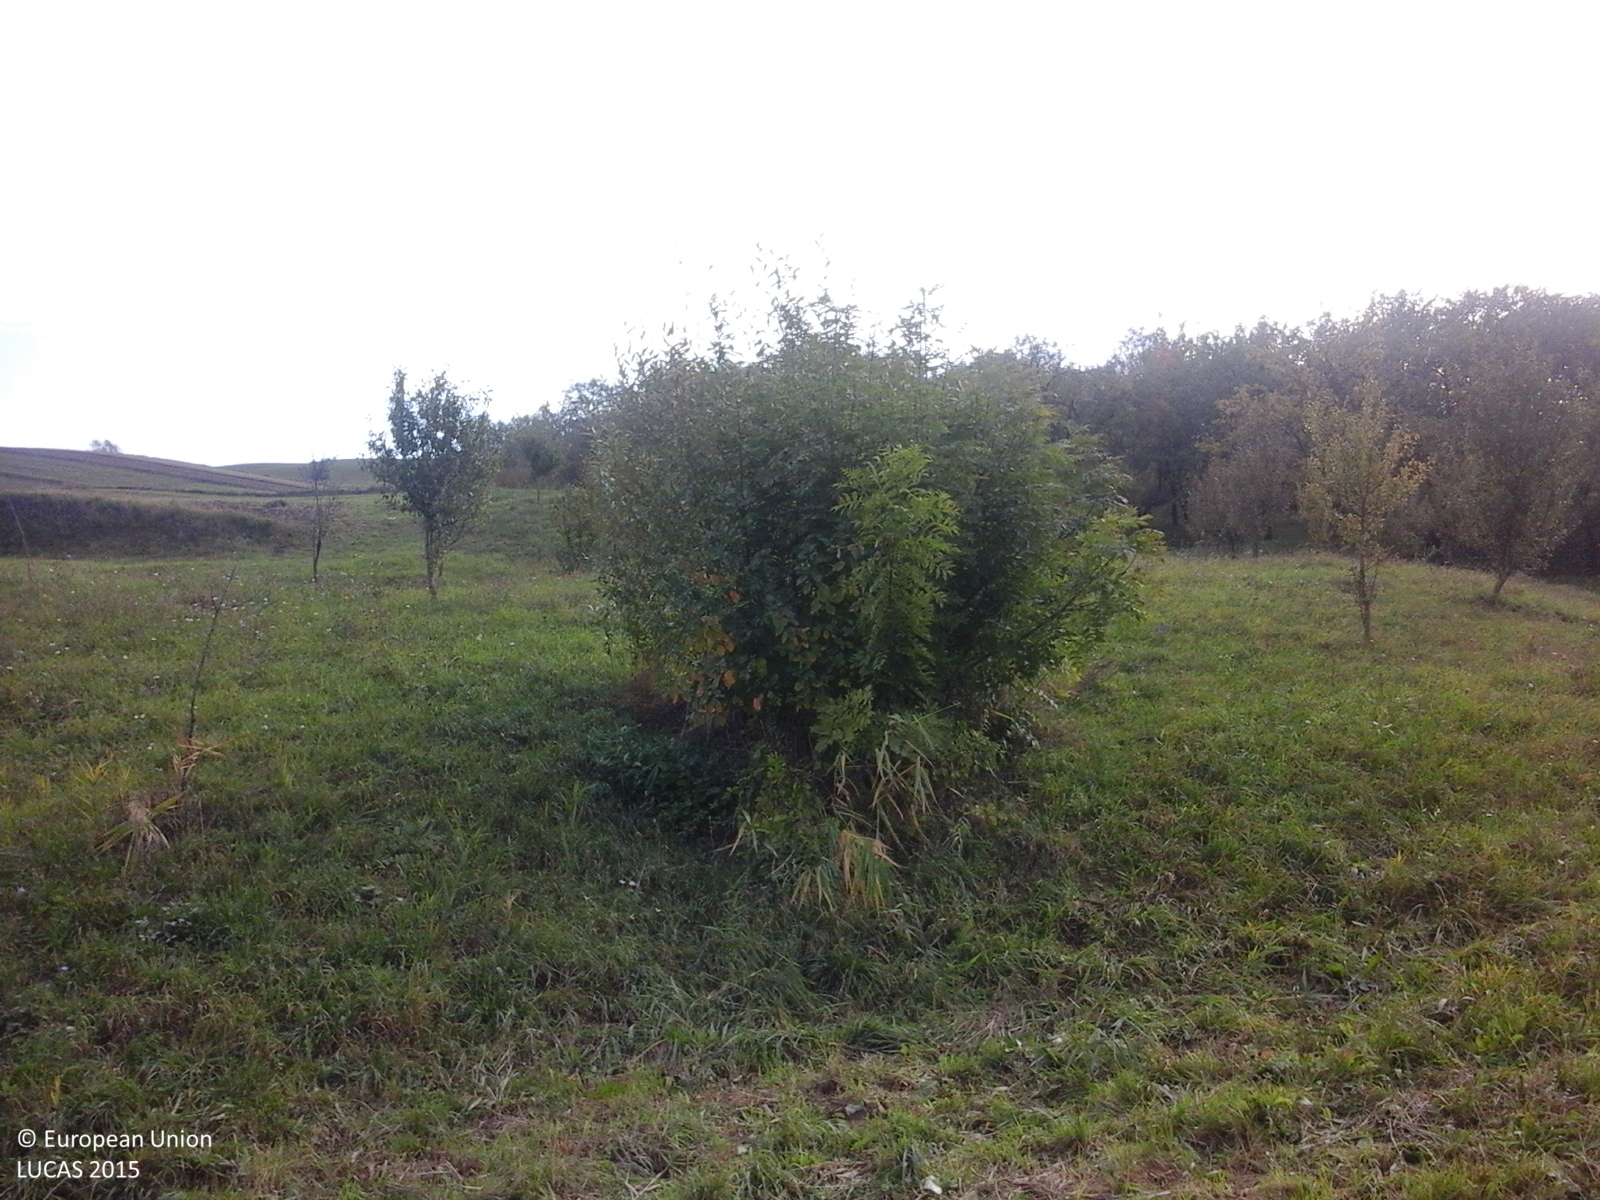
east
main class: Grassland
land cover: Grassland without tree/shrub cover
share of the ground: > 75 %
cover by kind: herbaceous plants 100 %
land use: Agriculture (excluding fallow land and kitchen gardens)
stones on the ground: < 10 %
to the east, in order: Grassland without tree/shrub cover; Other fruit trees and berries; Grassland without tree/shrub cover; Other bare soil; Grassland without tree/shrub cover
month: October
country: RO
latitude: 46.3741
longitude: 25.3272
